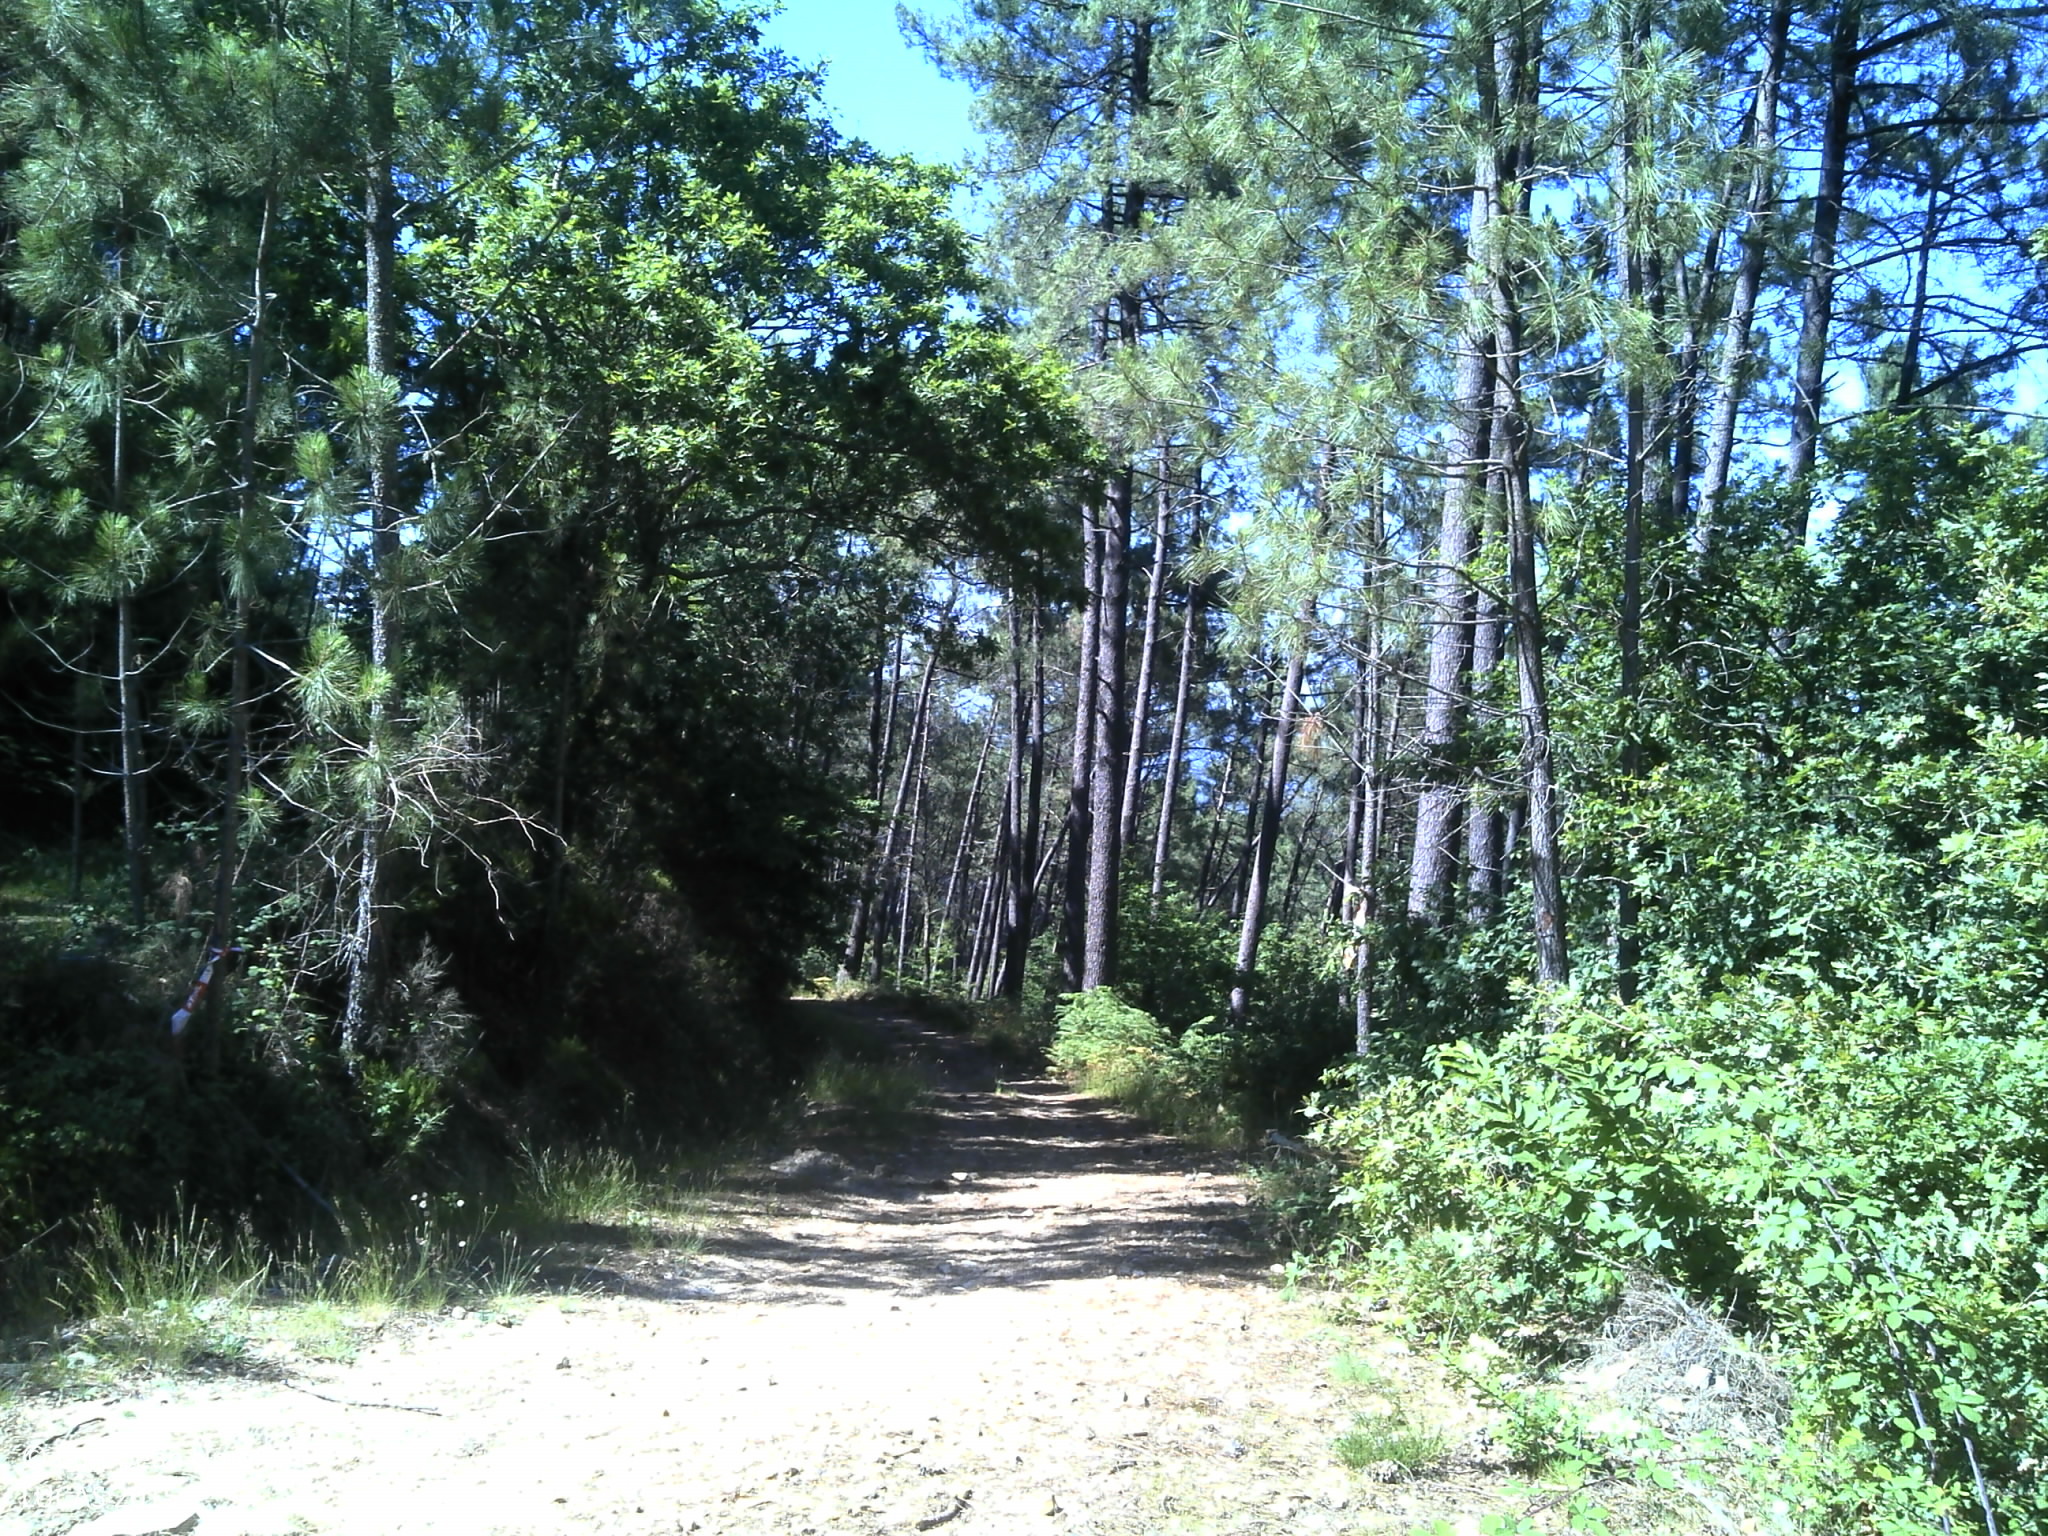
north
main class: Woodland
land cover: Pine dominated coniferous woodland
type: coniferous forest of the mediterranean region
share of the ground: 50 - 75 %
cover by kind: coniferous forest trees 60 %, shrubs 25 %, unconsolidated bare surface 15 %
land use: Forestry
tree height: > 5 m
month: June
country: PT
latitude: 40.6269
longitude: -8.2565
